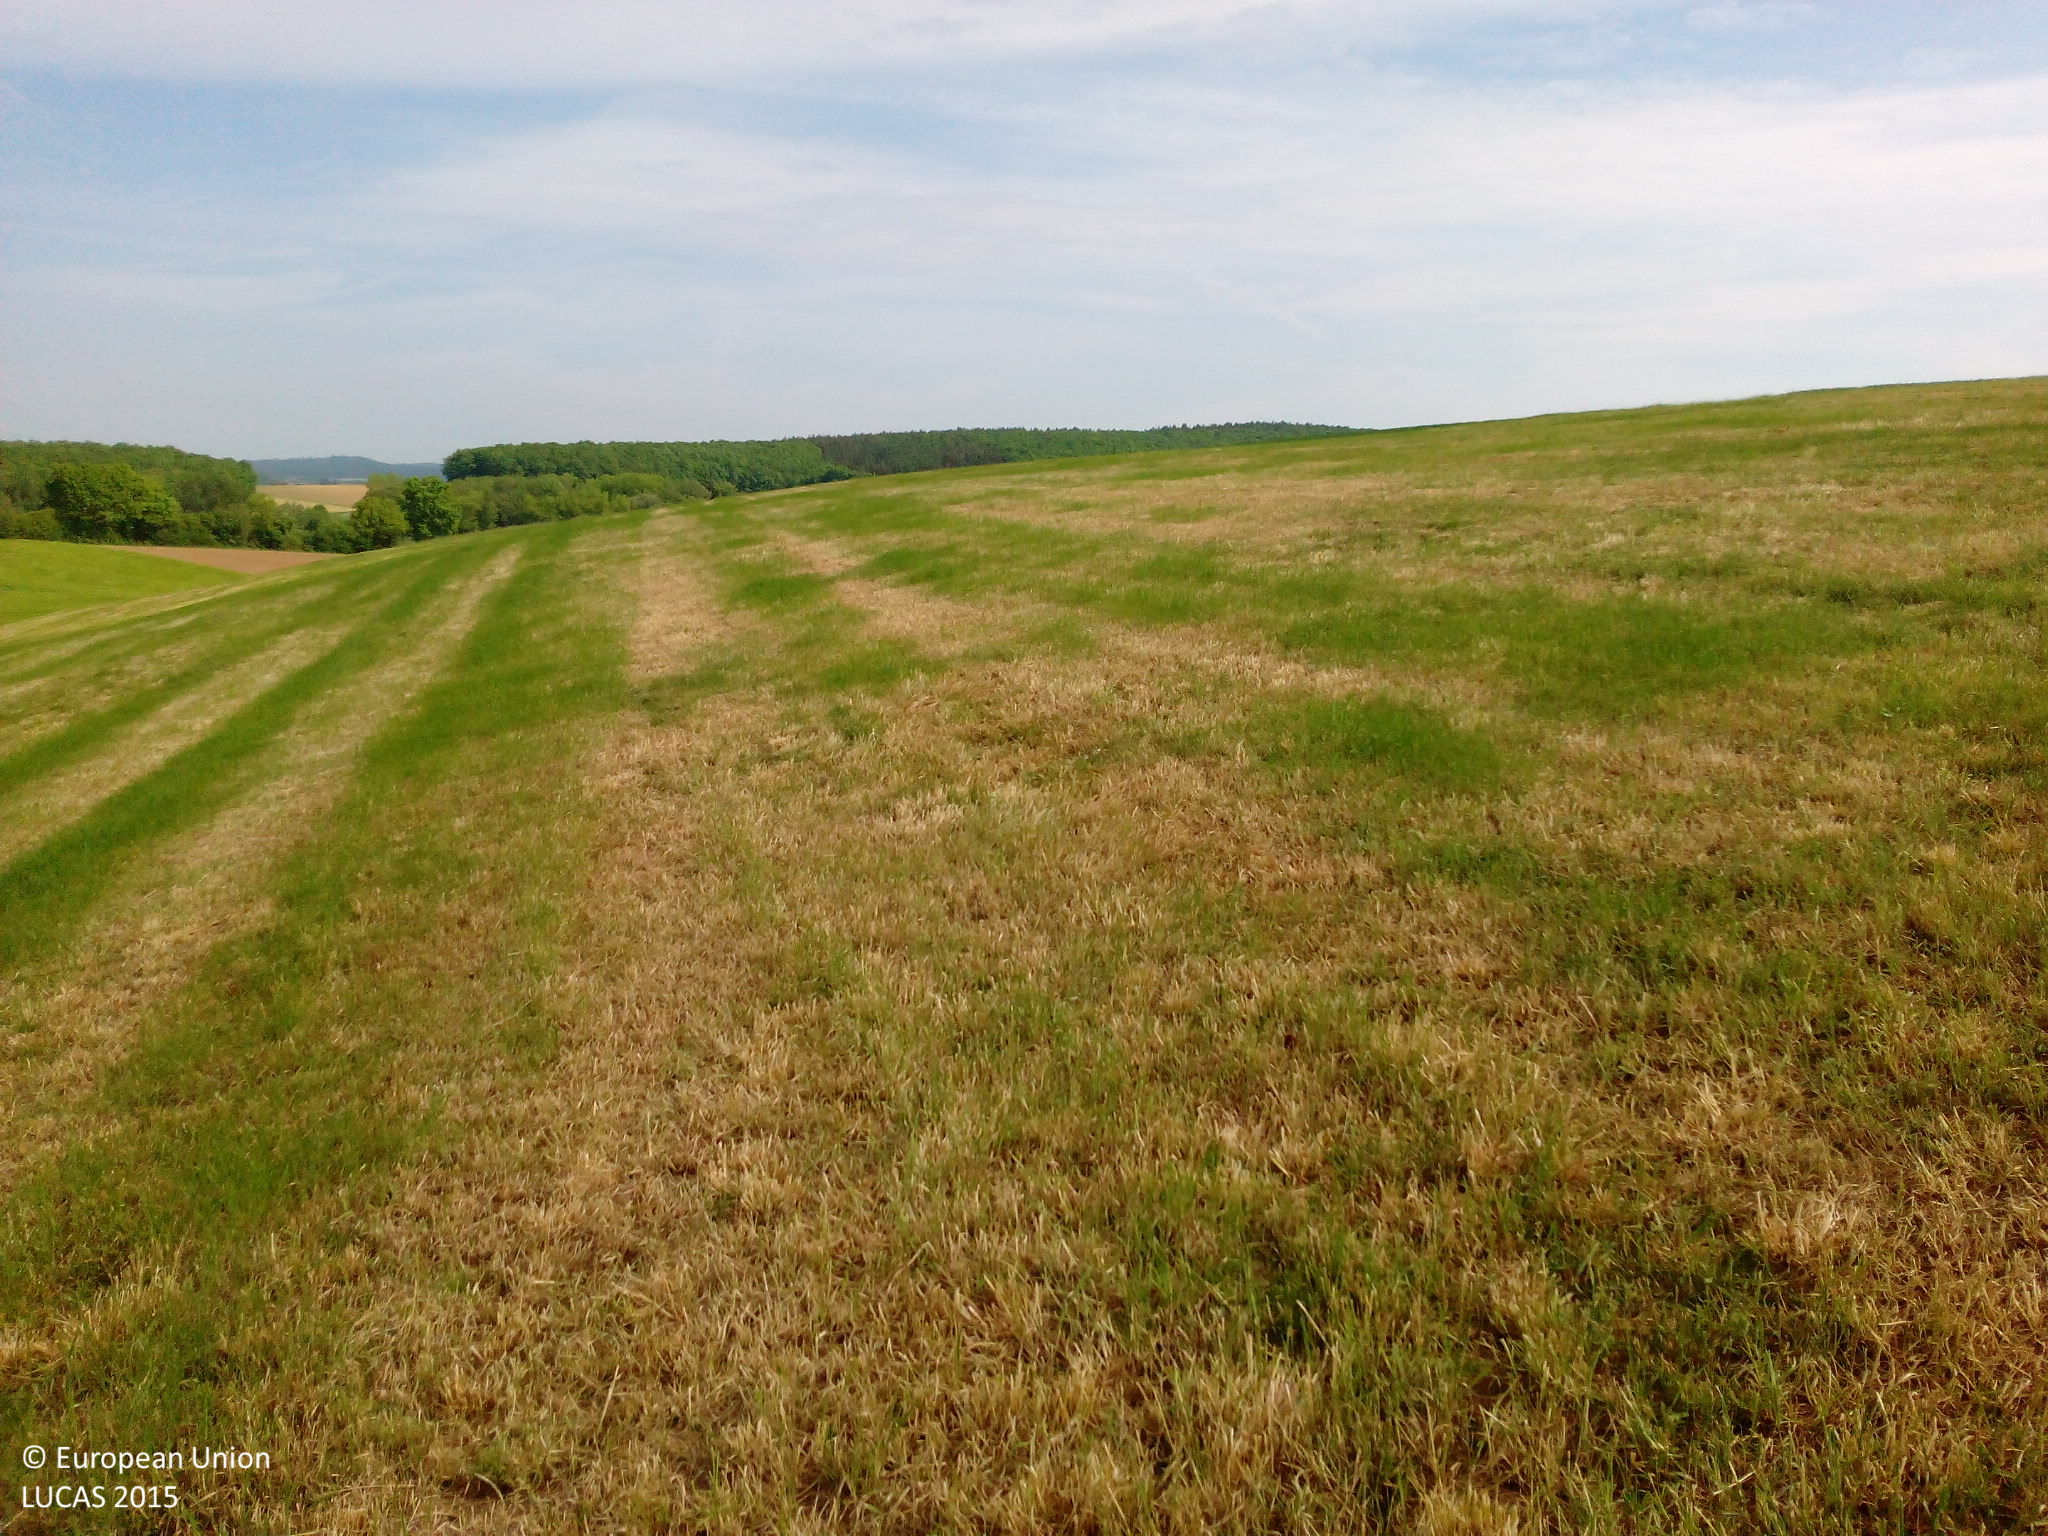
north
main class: Grassland
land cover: Grassland without tree/shrub cover
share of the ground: > 75 %
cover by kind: herbaceous plants 100 %
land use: Agriculture (excluding fallow land and kitchen gardens)
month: May
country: DE
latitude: 50.1444
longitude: 10.9373
